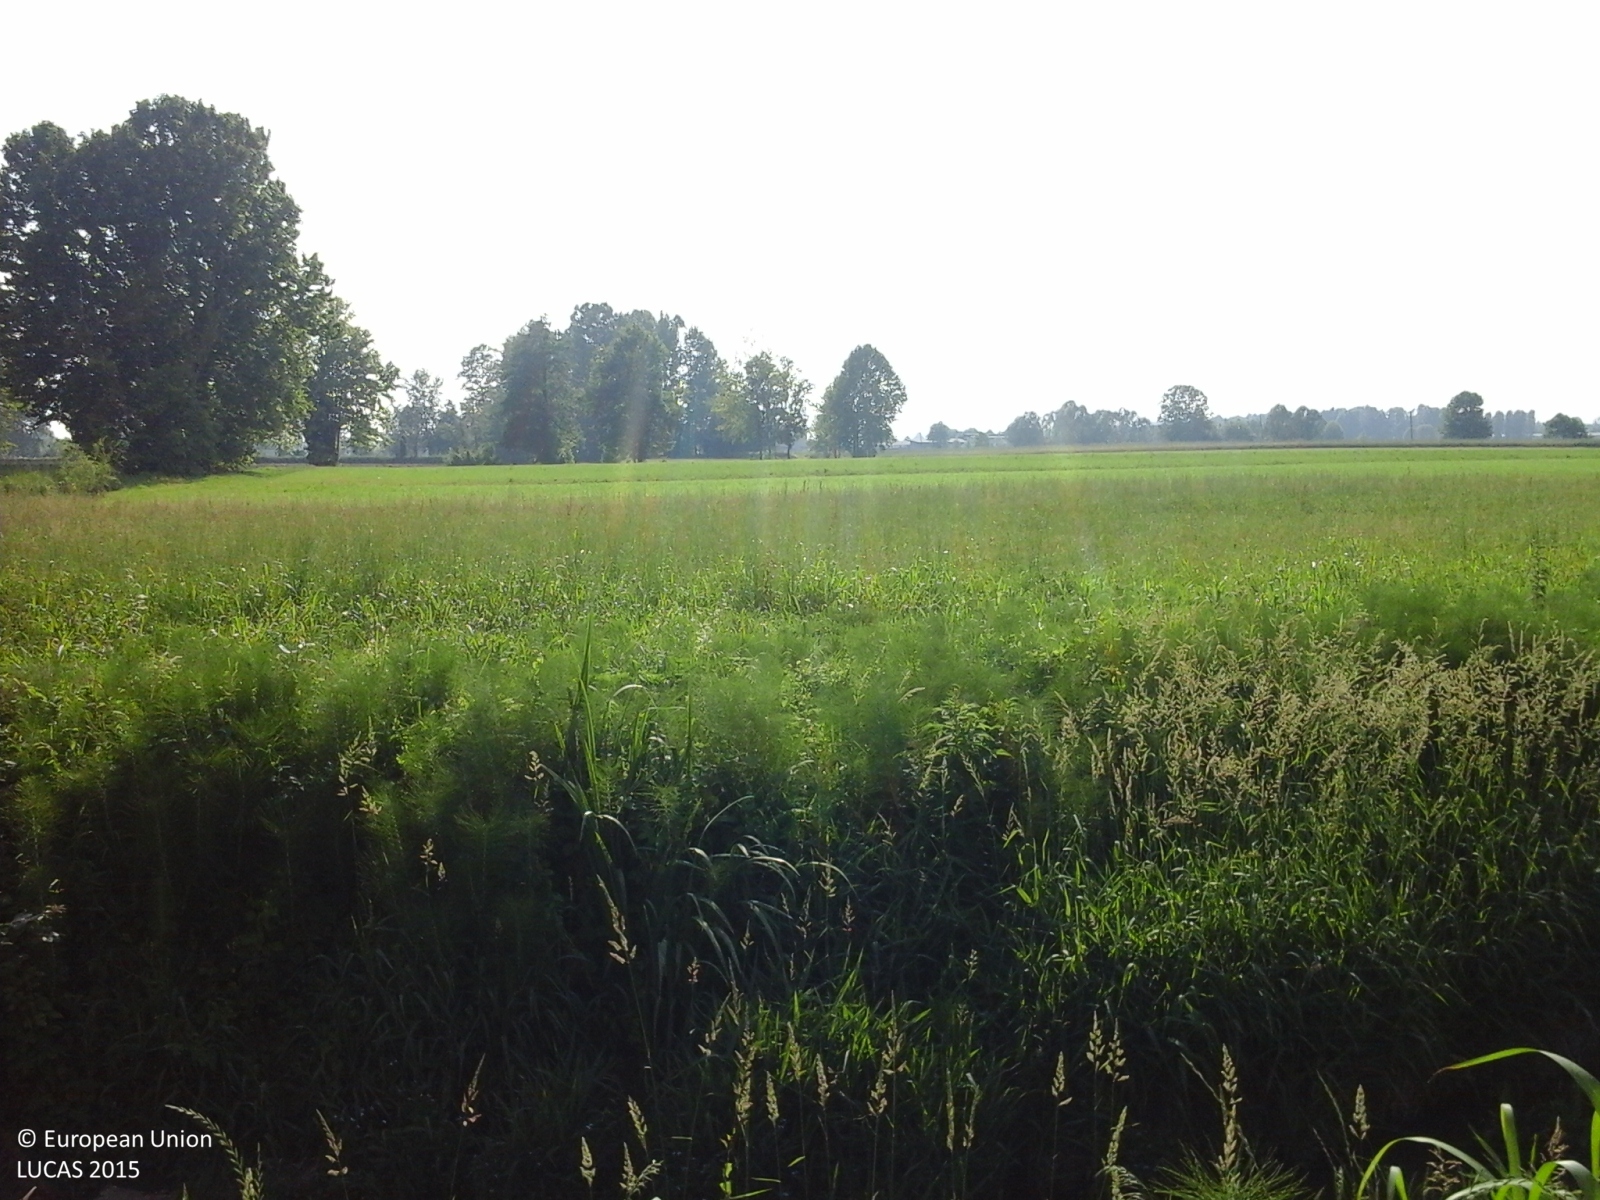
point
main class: Cropland
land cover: Lucerne
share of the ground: > 75 %
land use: Agriculture (excluding fallow land and kitchen gardens)
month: May
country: IT
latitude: 45.5039
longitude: 9.6806
